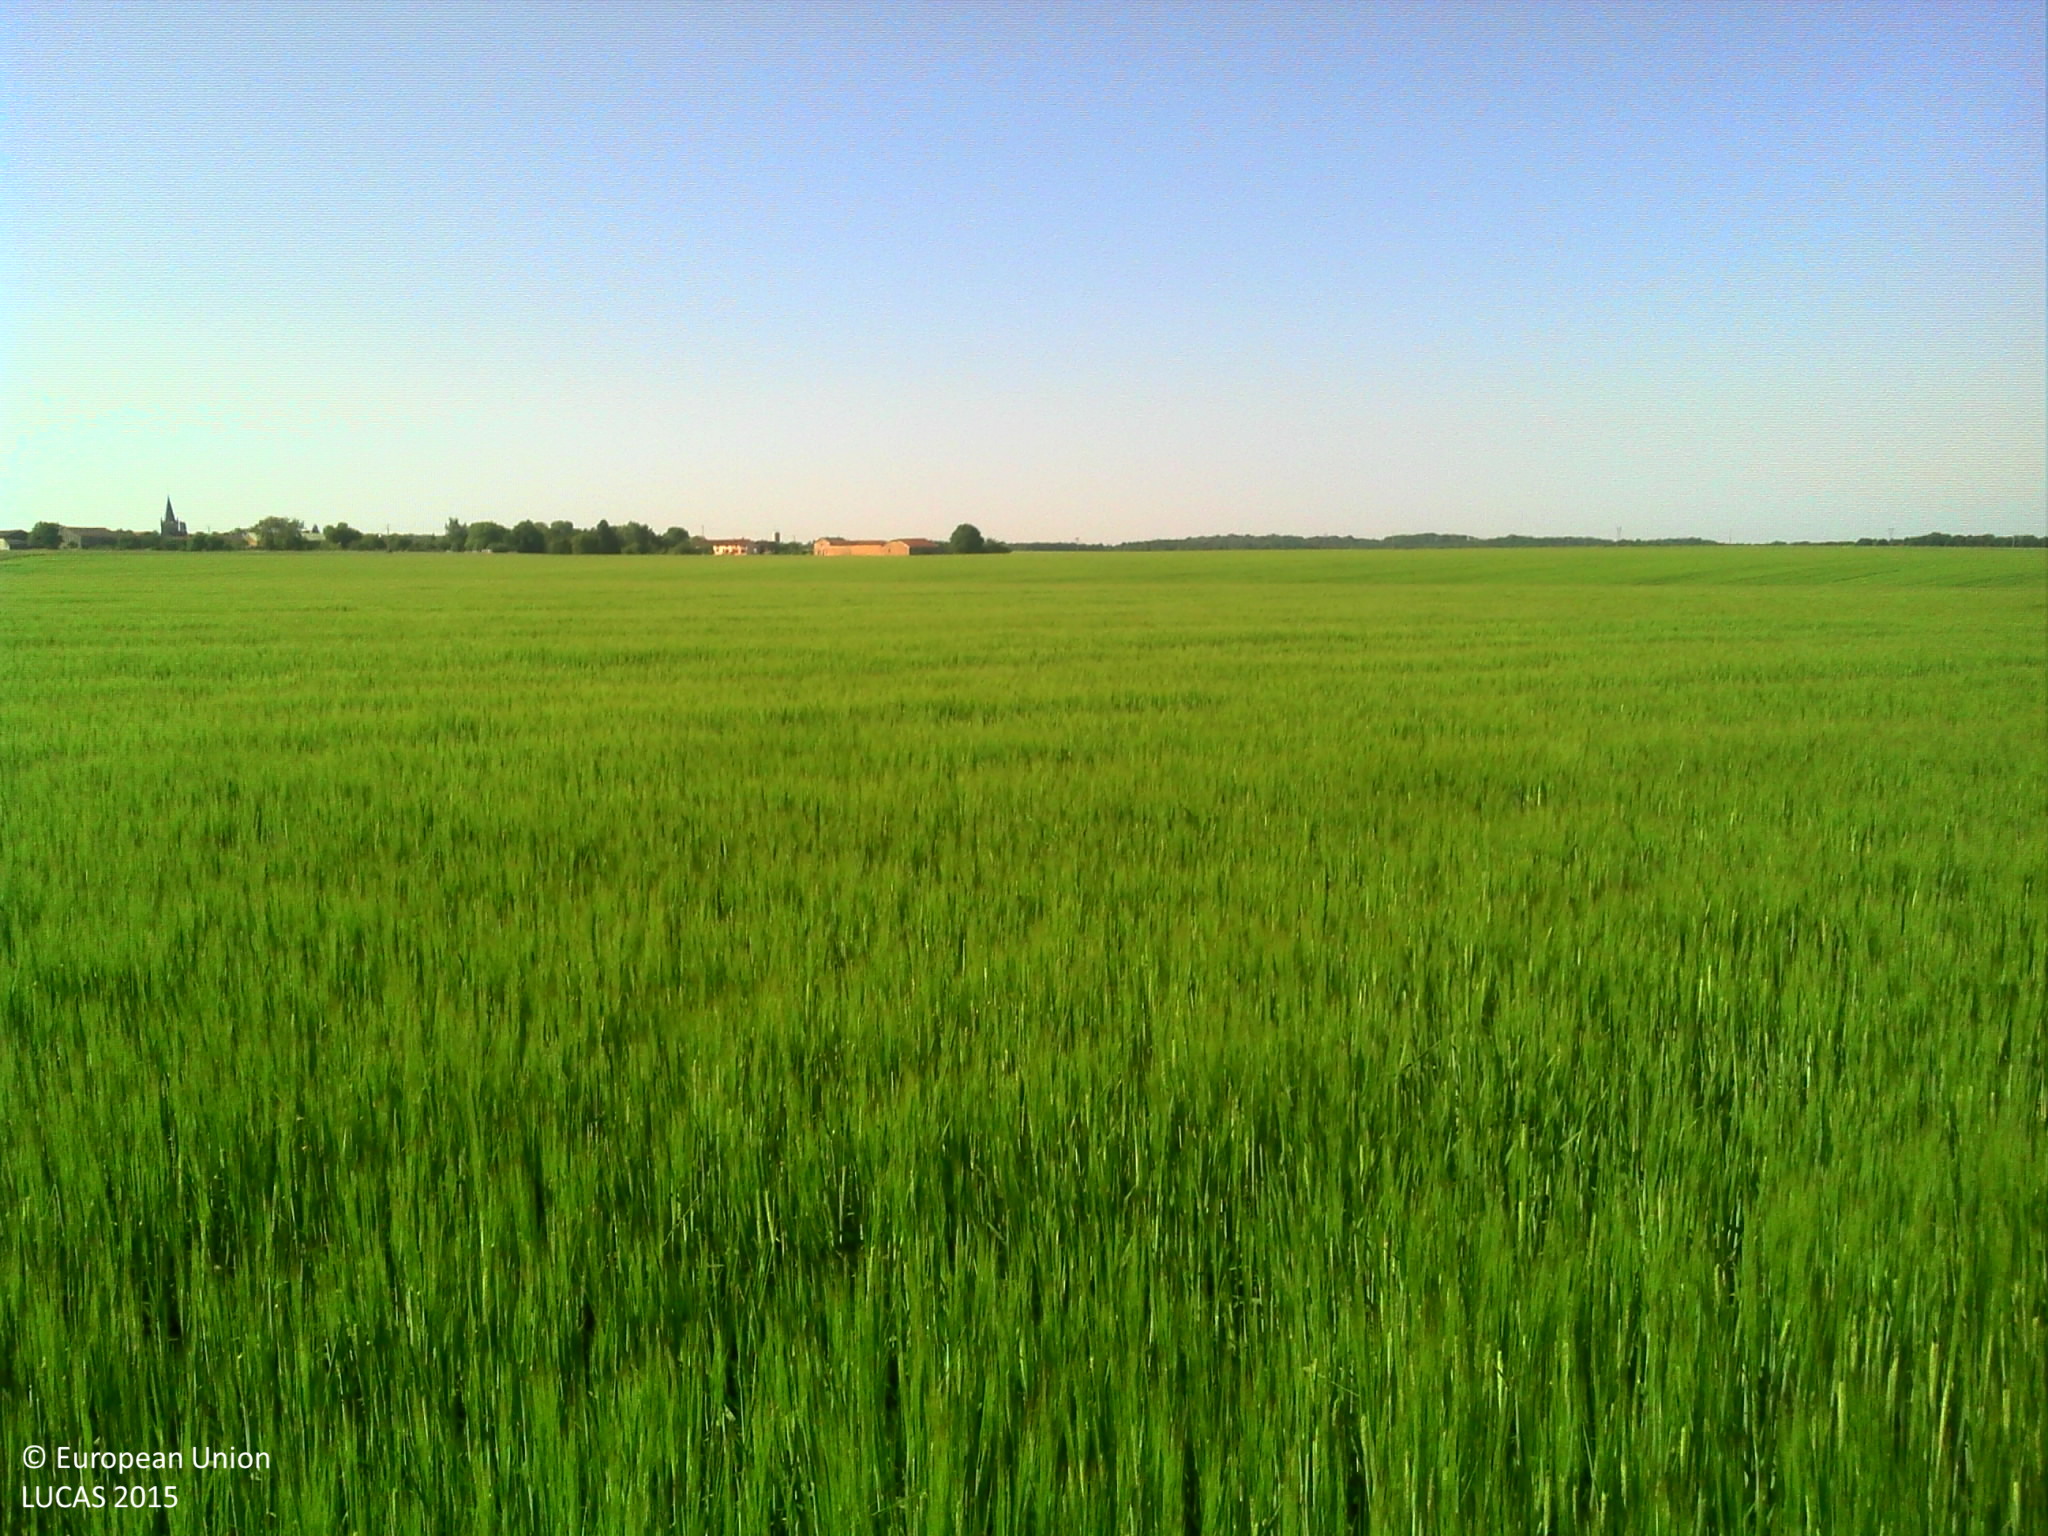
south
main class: Cropland
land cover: Barley
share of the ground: > 75 %
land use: Agriculture (excluding fallow land and kitchen gardens)
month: June
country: FR
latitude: 48.3739
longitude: 4.8547
